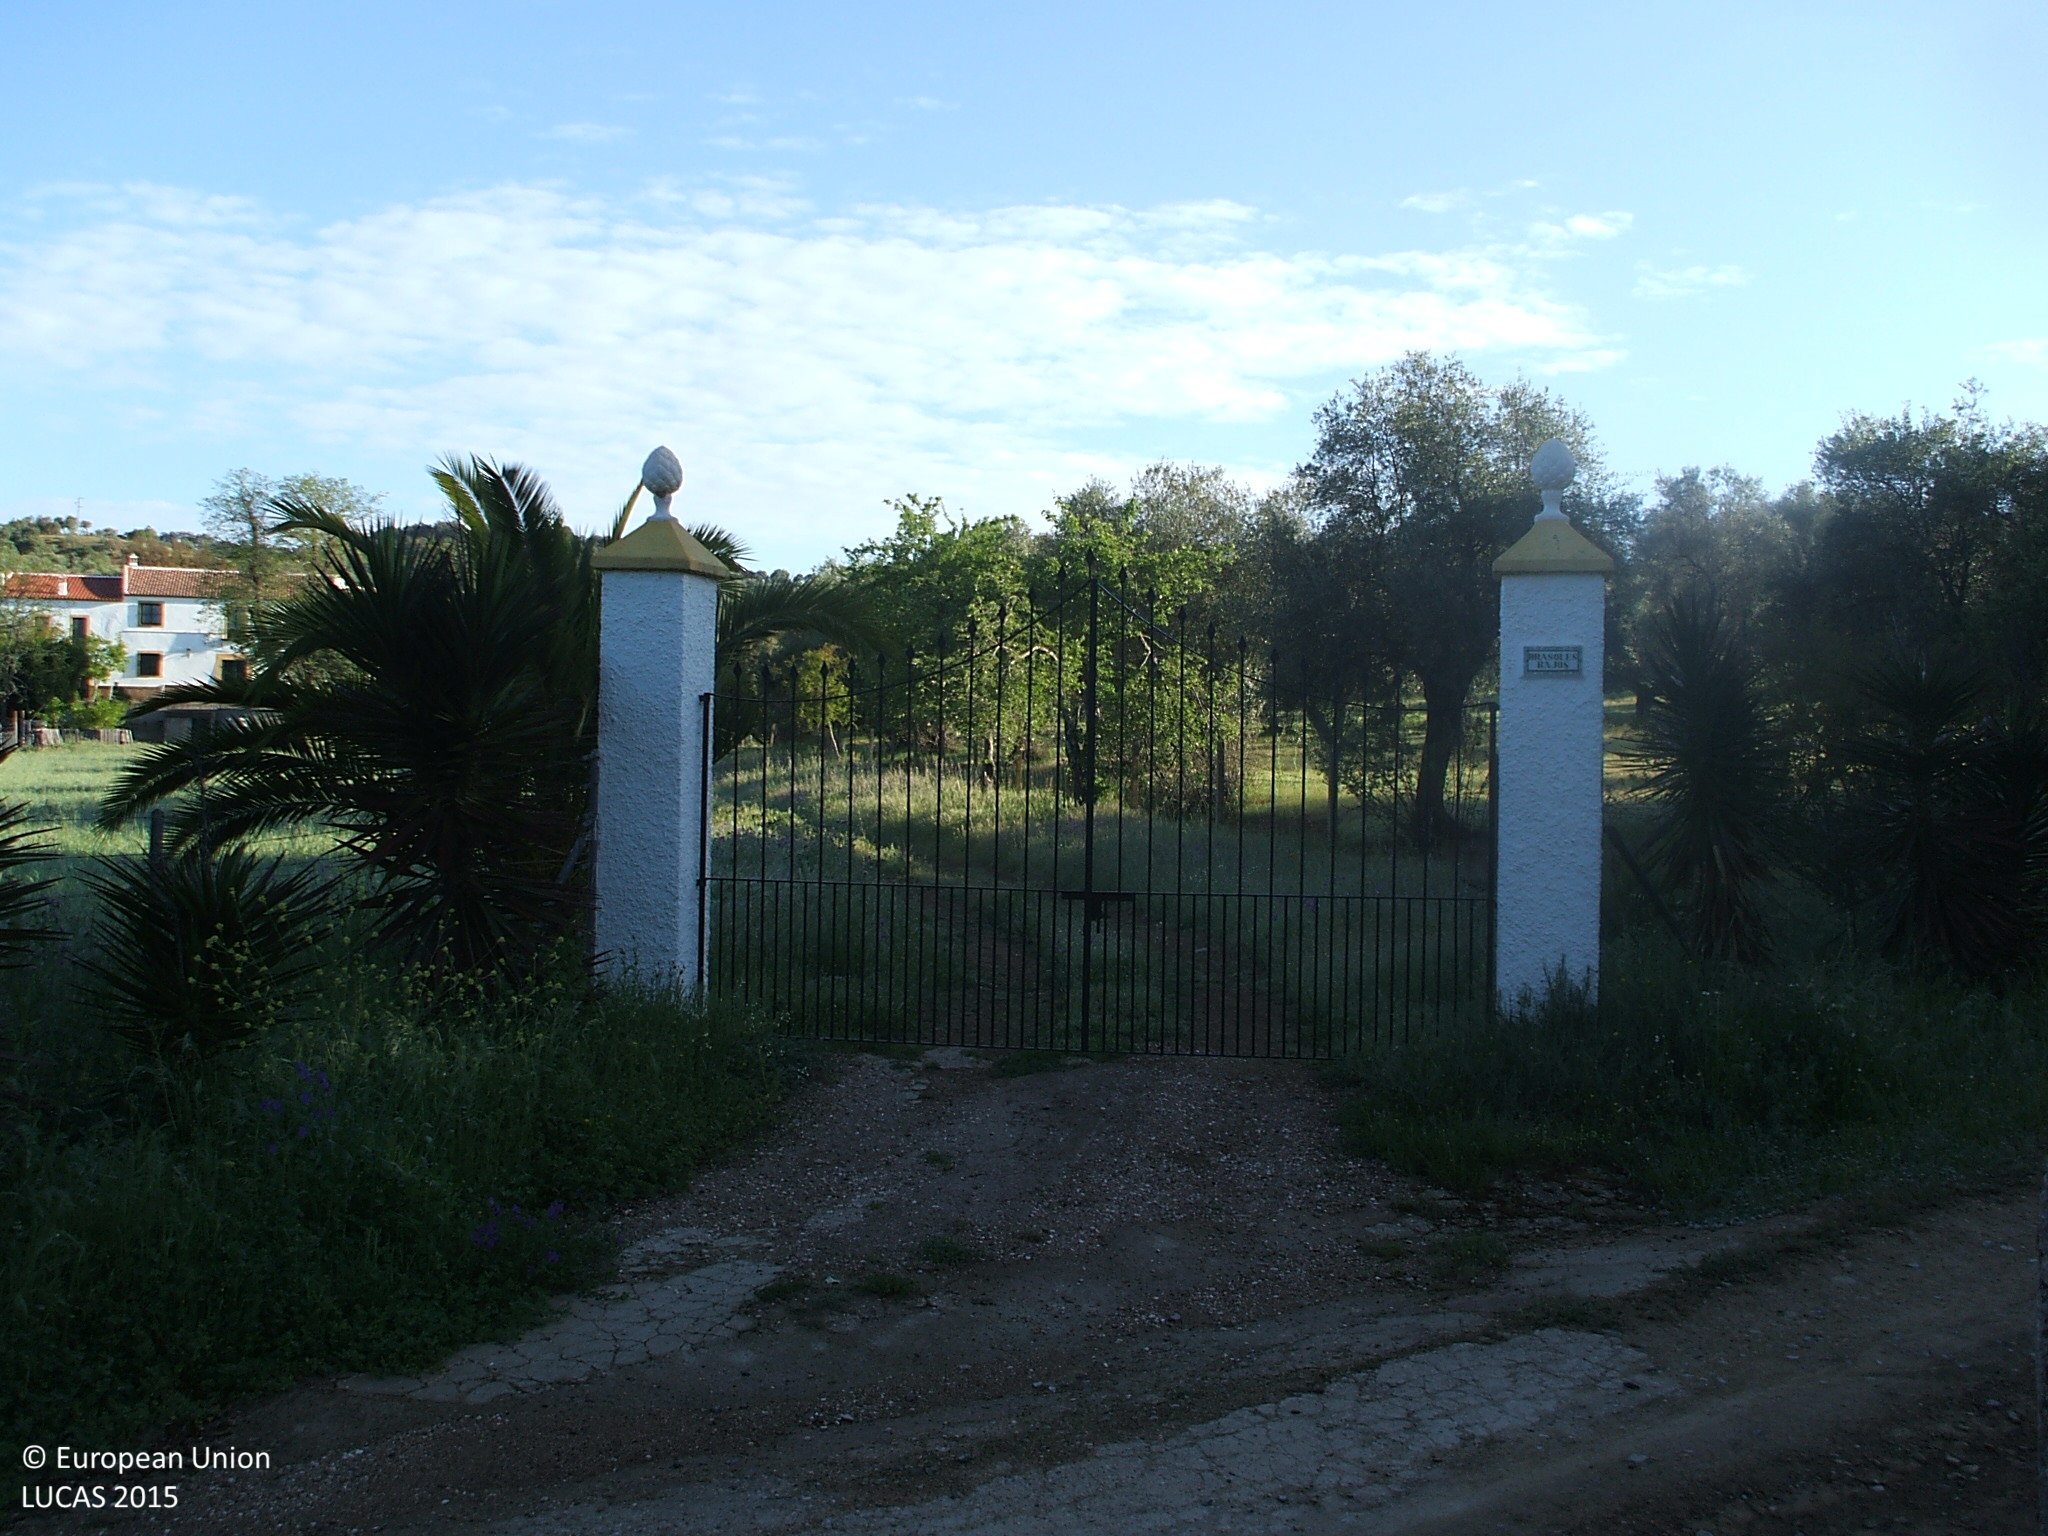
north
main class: Woodland
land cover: Broadleaved woodland
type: broadleaved evergreen forest
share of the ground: 50 - 75 %
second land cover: Grassland without tree/shrub cover
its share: > 75 %
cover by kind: broadleaved forest trees 60 %, herbaceous plants 40 %
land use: Forestry
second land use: Agriculture (excluding fallow land and kitchen gardens)
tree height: > 5 m
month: April
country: ES
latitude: 37.9035
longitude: -5.6196
